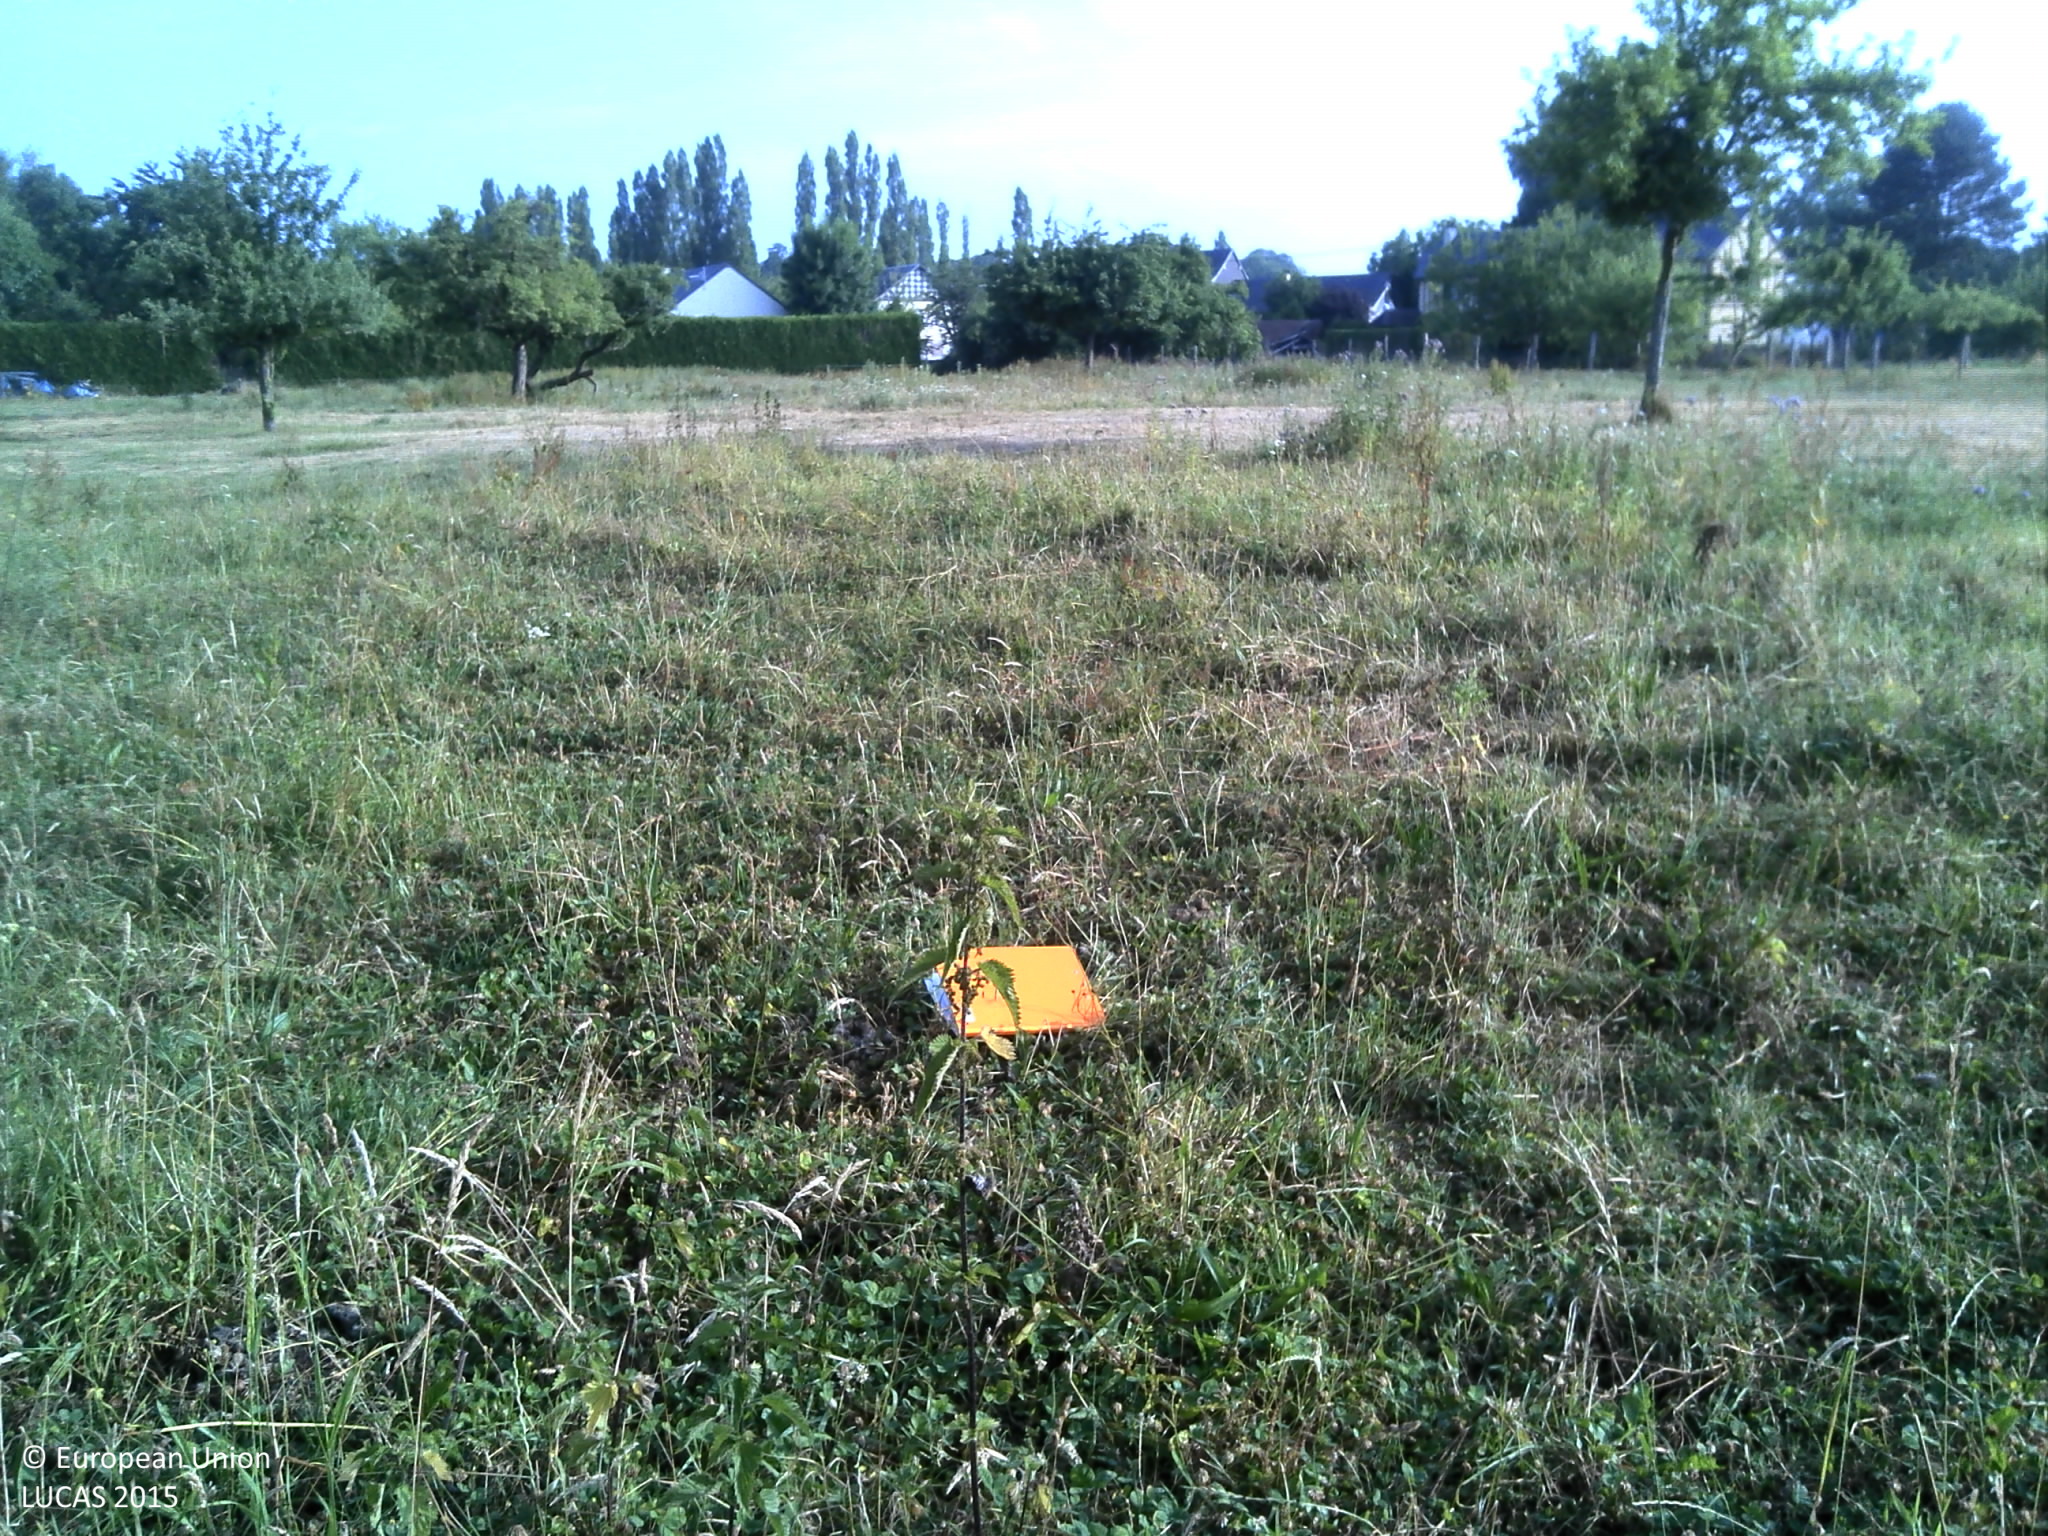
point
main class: Grassland
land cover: Grassland without tree/shrub cover
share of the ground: > 75 %
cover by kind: herbaceous plants 100 %
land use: Agriculture (excluding fallow land and kitchen gardens)
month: July
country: FR
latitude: 49.3693
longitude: 1.1517
